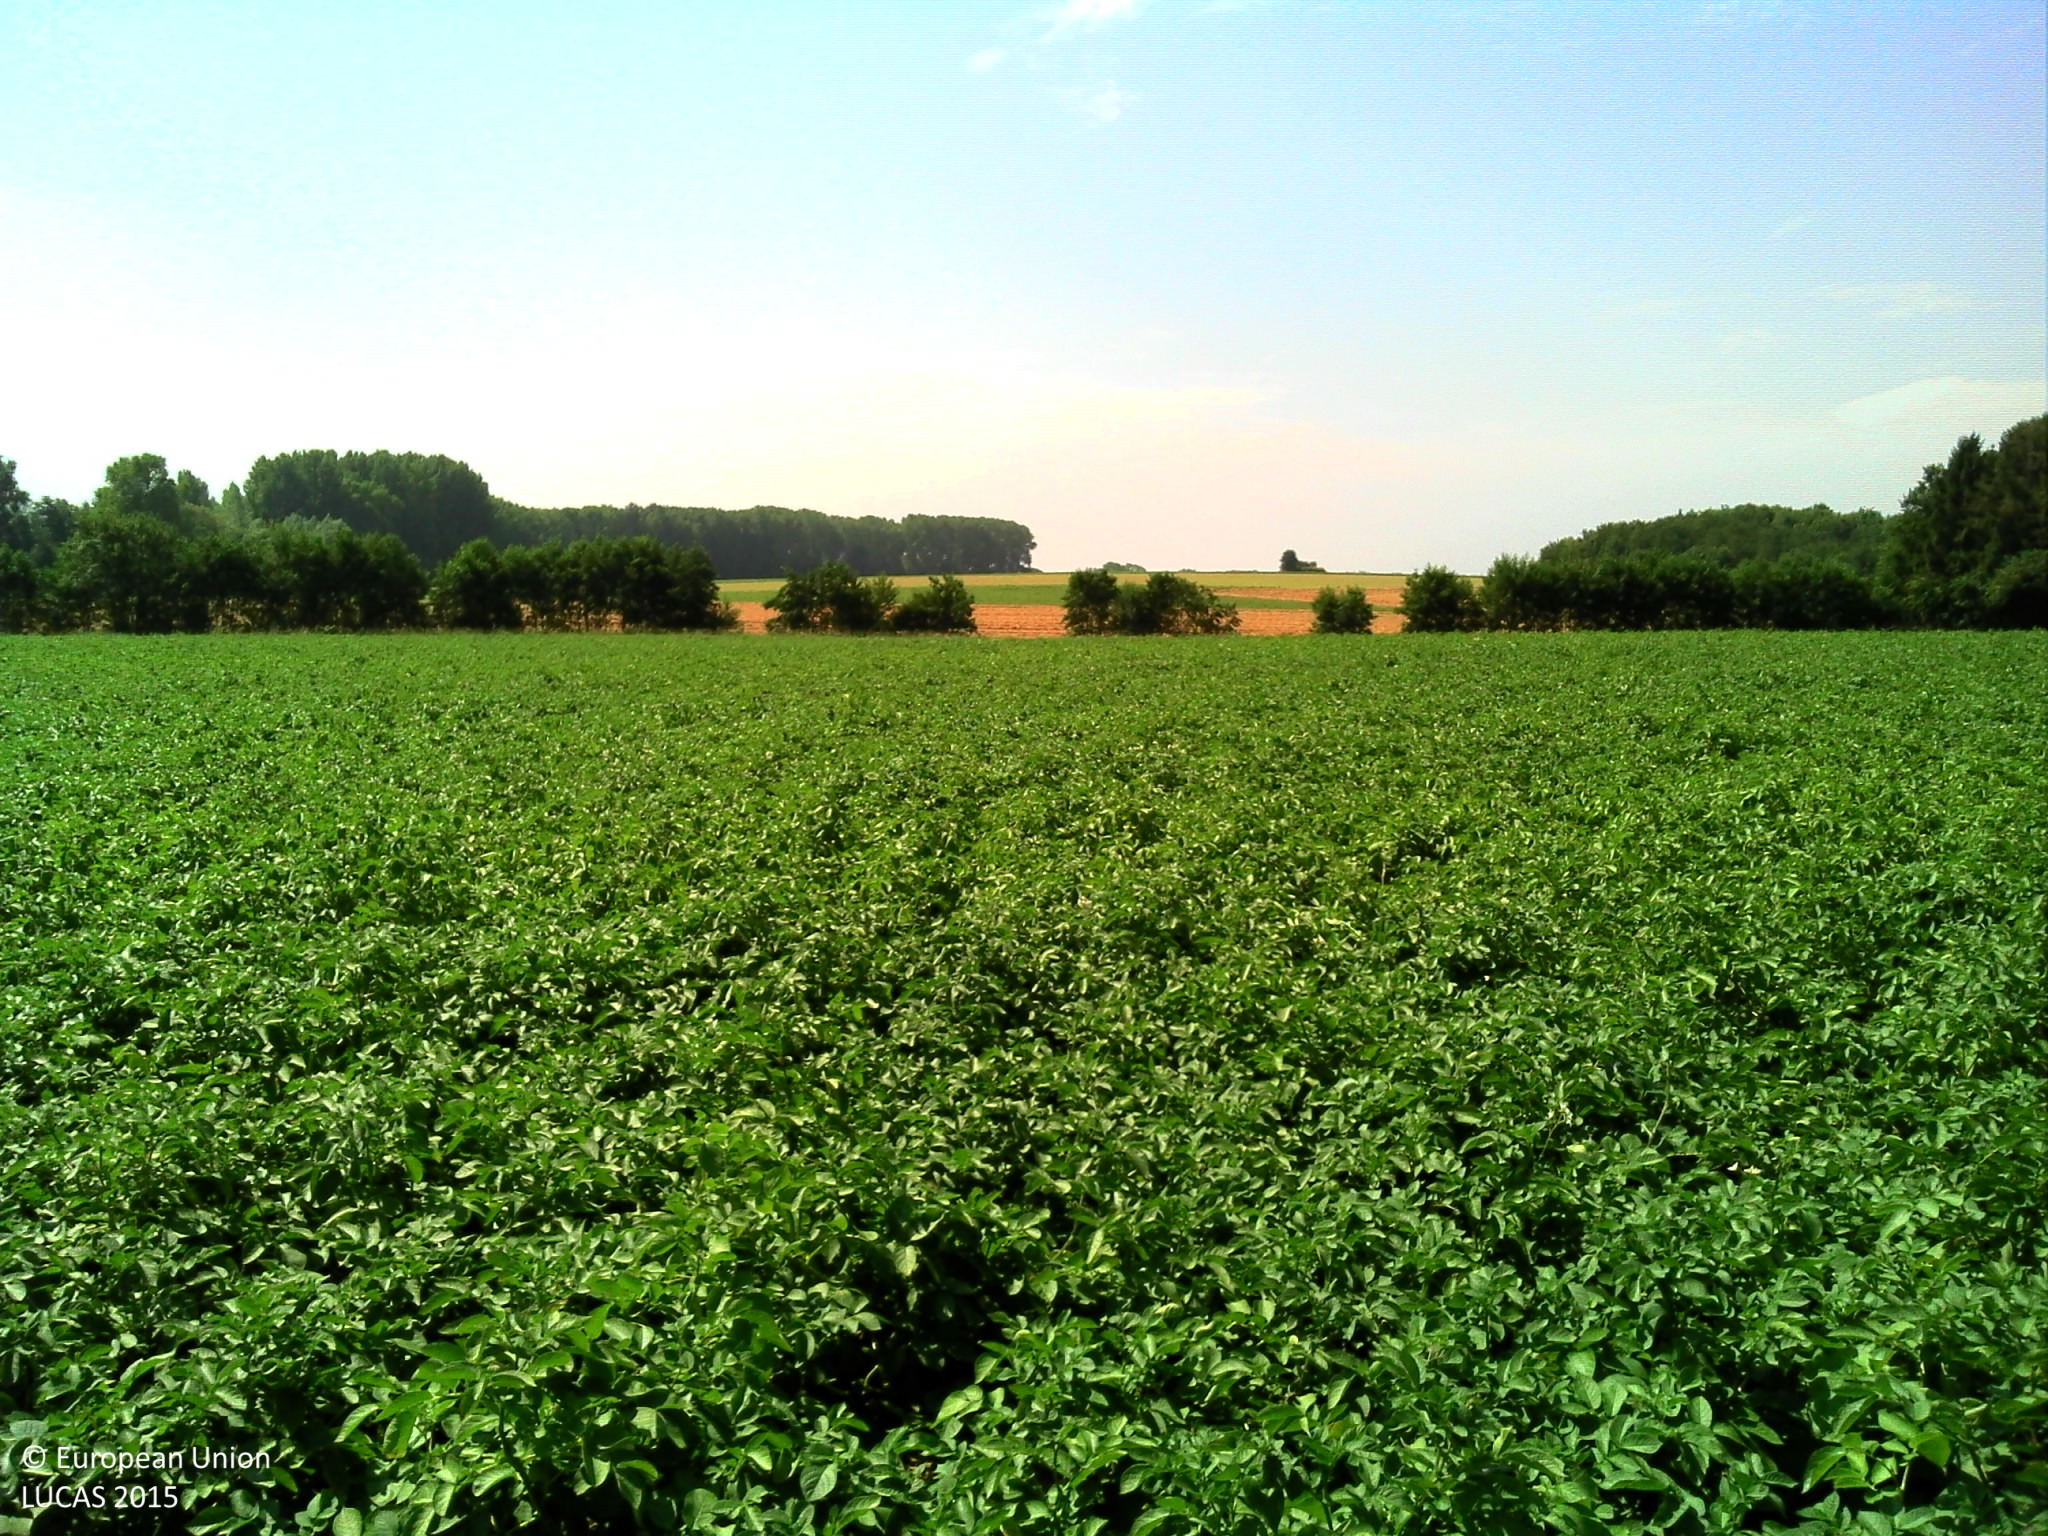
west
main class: Cropland
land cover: Potatoes
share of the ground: > 75 %
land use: Agriculture (excluding fallow land and kitchen gardens)
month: August
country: FR
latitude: 50.3296
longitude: 3.9395
